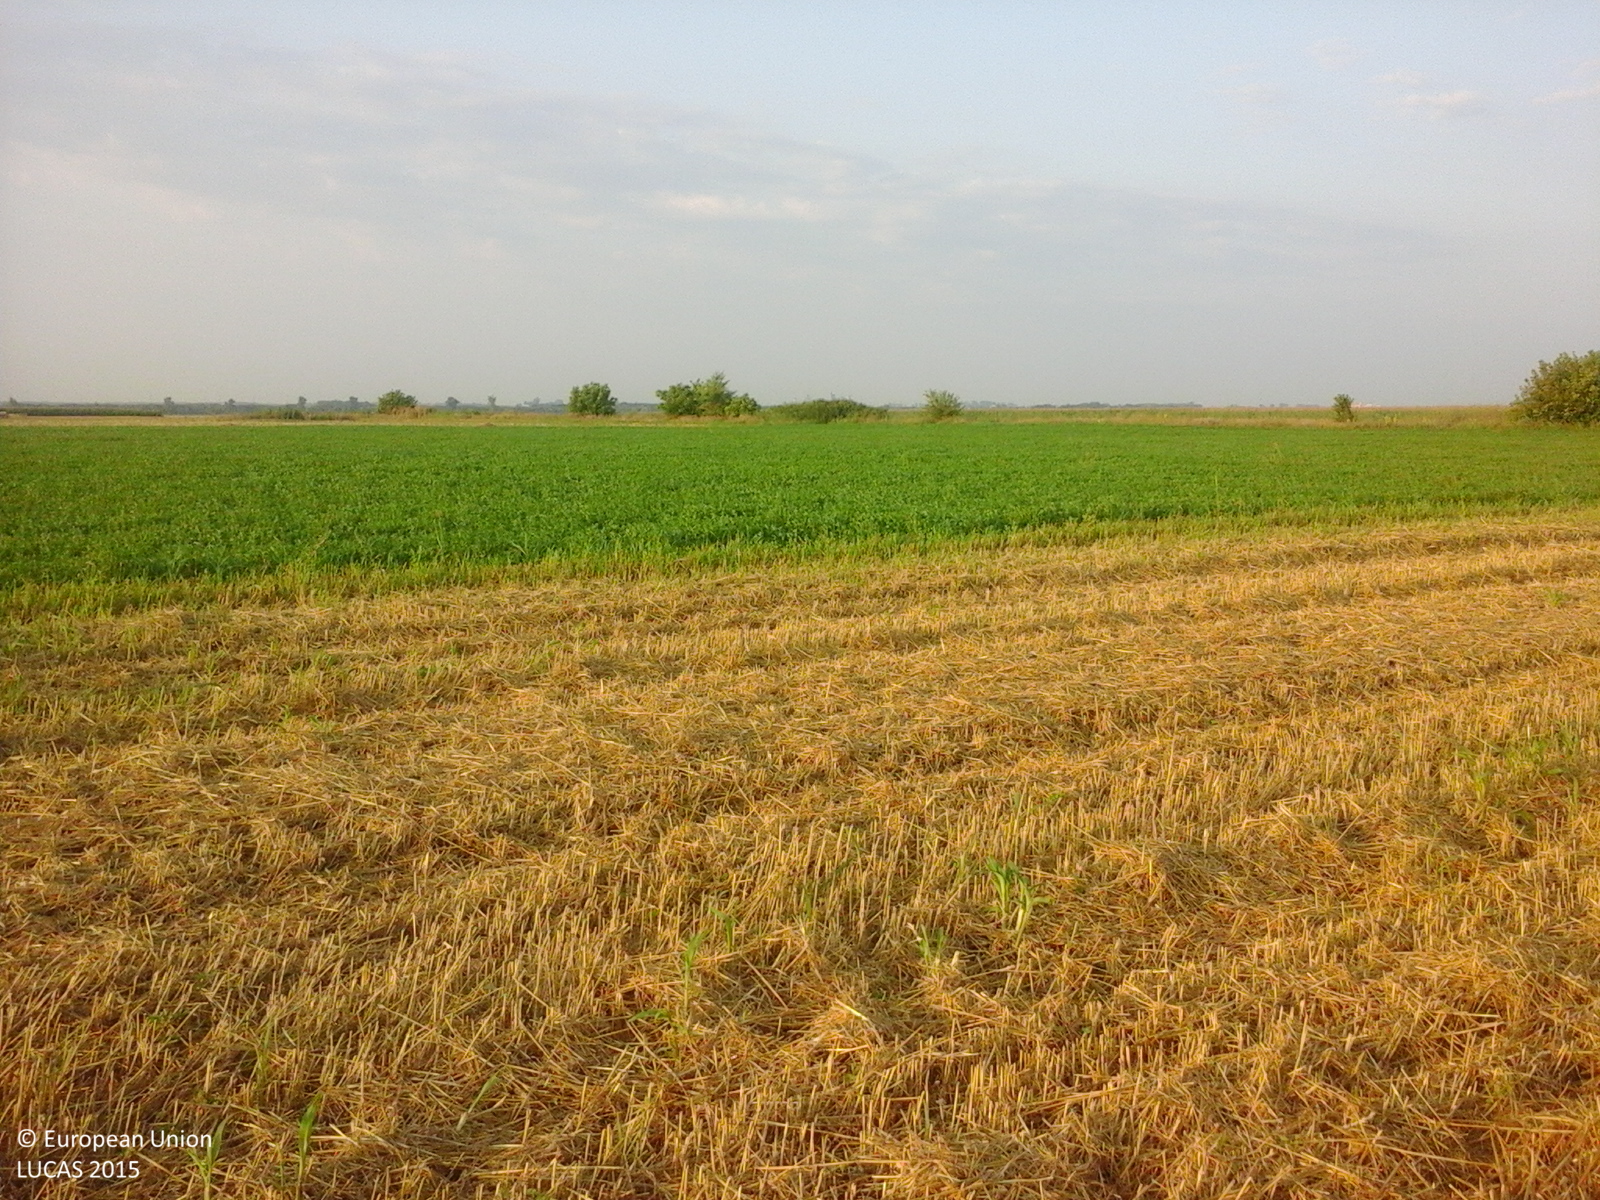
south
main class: Cropland
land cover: Common wheat
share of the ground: 10 - 25 %
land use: Agriculture (excluding fallow land and kitchen gardens)
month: July
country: RO
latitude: 44.5957
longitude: 27.4128
